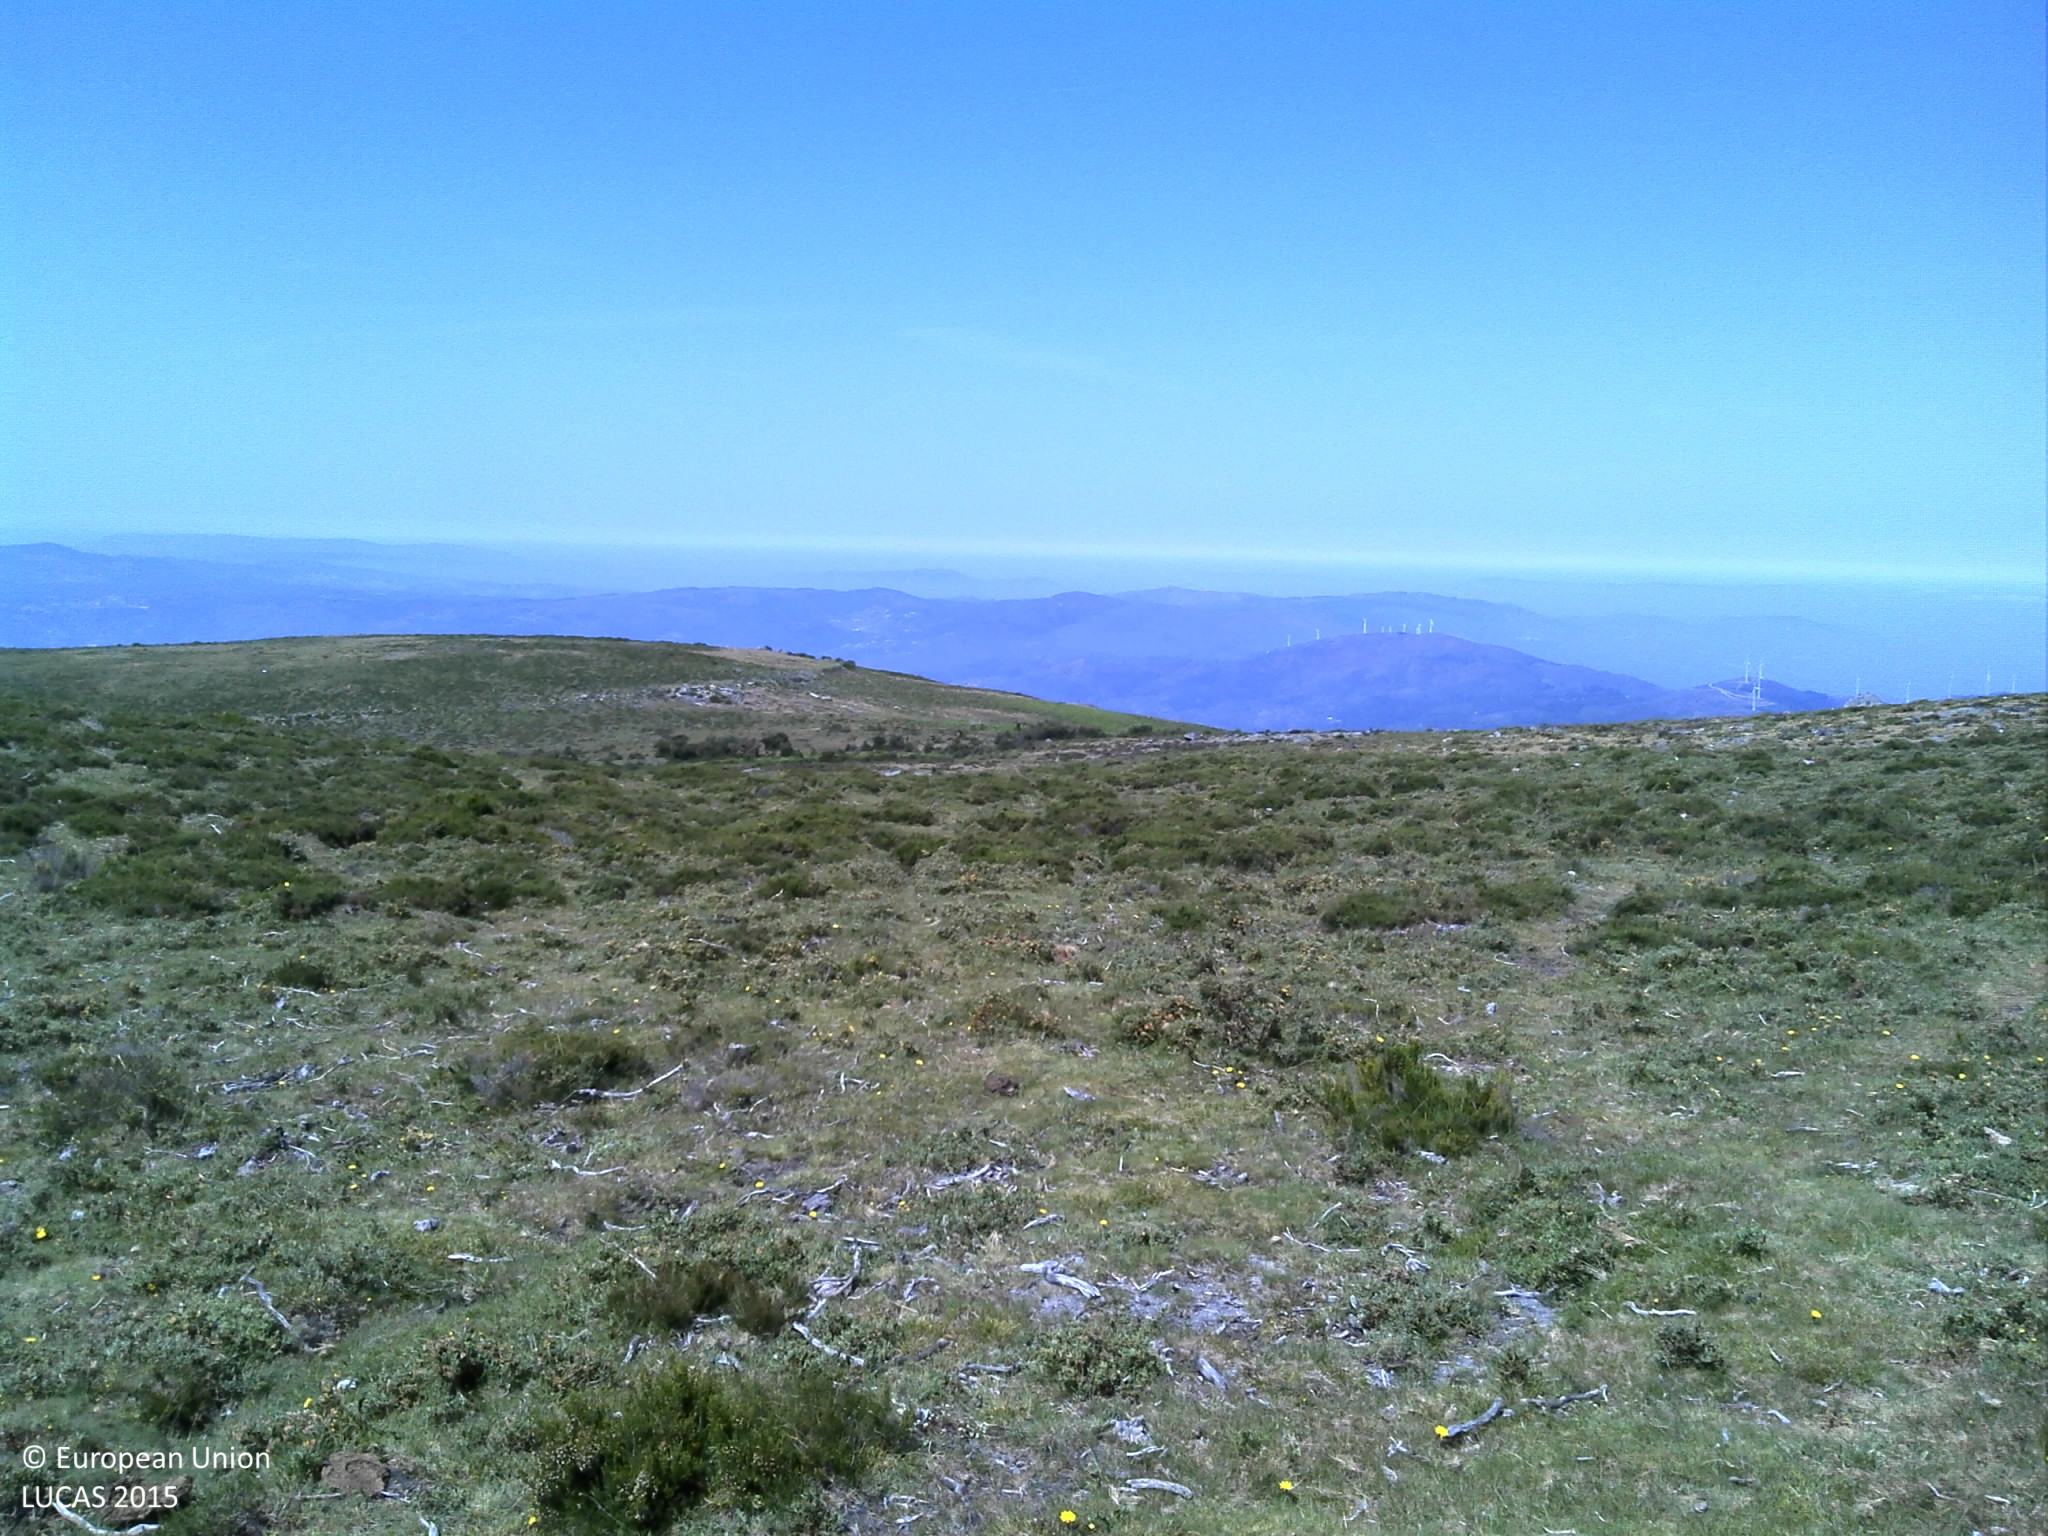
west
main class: Shrubland
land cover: Shrubland without tree cover
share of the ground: 50 - 75 %
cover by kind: shrubs 70 %, herbaceous plants 20 %, consolidated bare surface 5 %, unconsolidated bare surface 5 %
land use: Agriculture (excluding fallow land and kitchen gardens)
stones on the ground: < 10 %
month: June
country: PT
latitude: 41.9642
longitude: -8.3167
